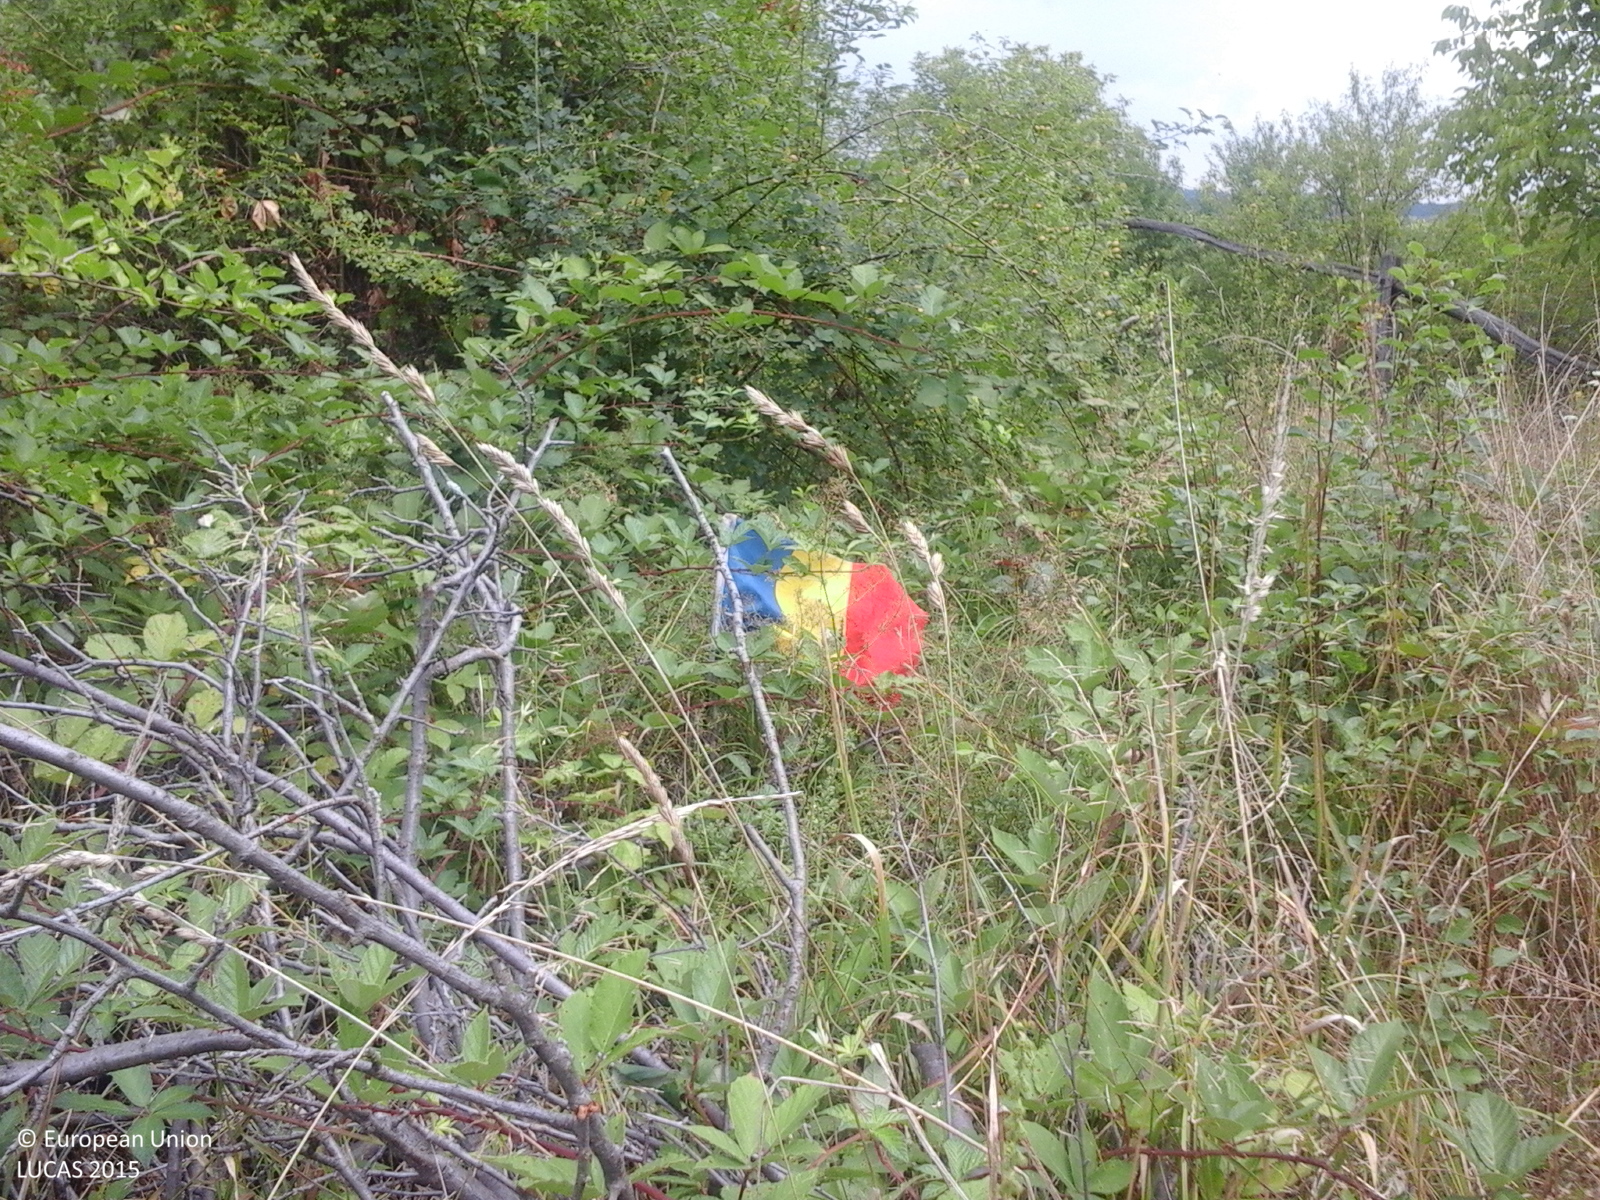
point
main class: Shrubland
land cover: Shrubland with sparse tree cover
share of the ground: > 75 %
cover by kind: shrubs 85 %, herbaceous plants 10 %, broadleaved forest trees 5 %
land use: Fallow land
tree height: > 5 m
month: August
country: RO
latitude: 44.8478
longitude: 22.8116
